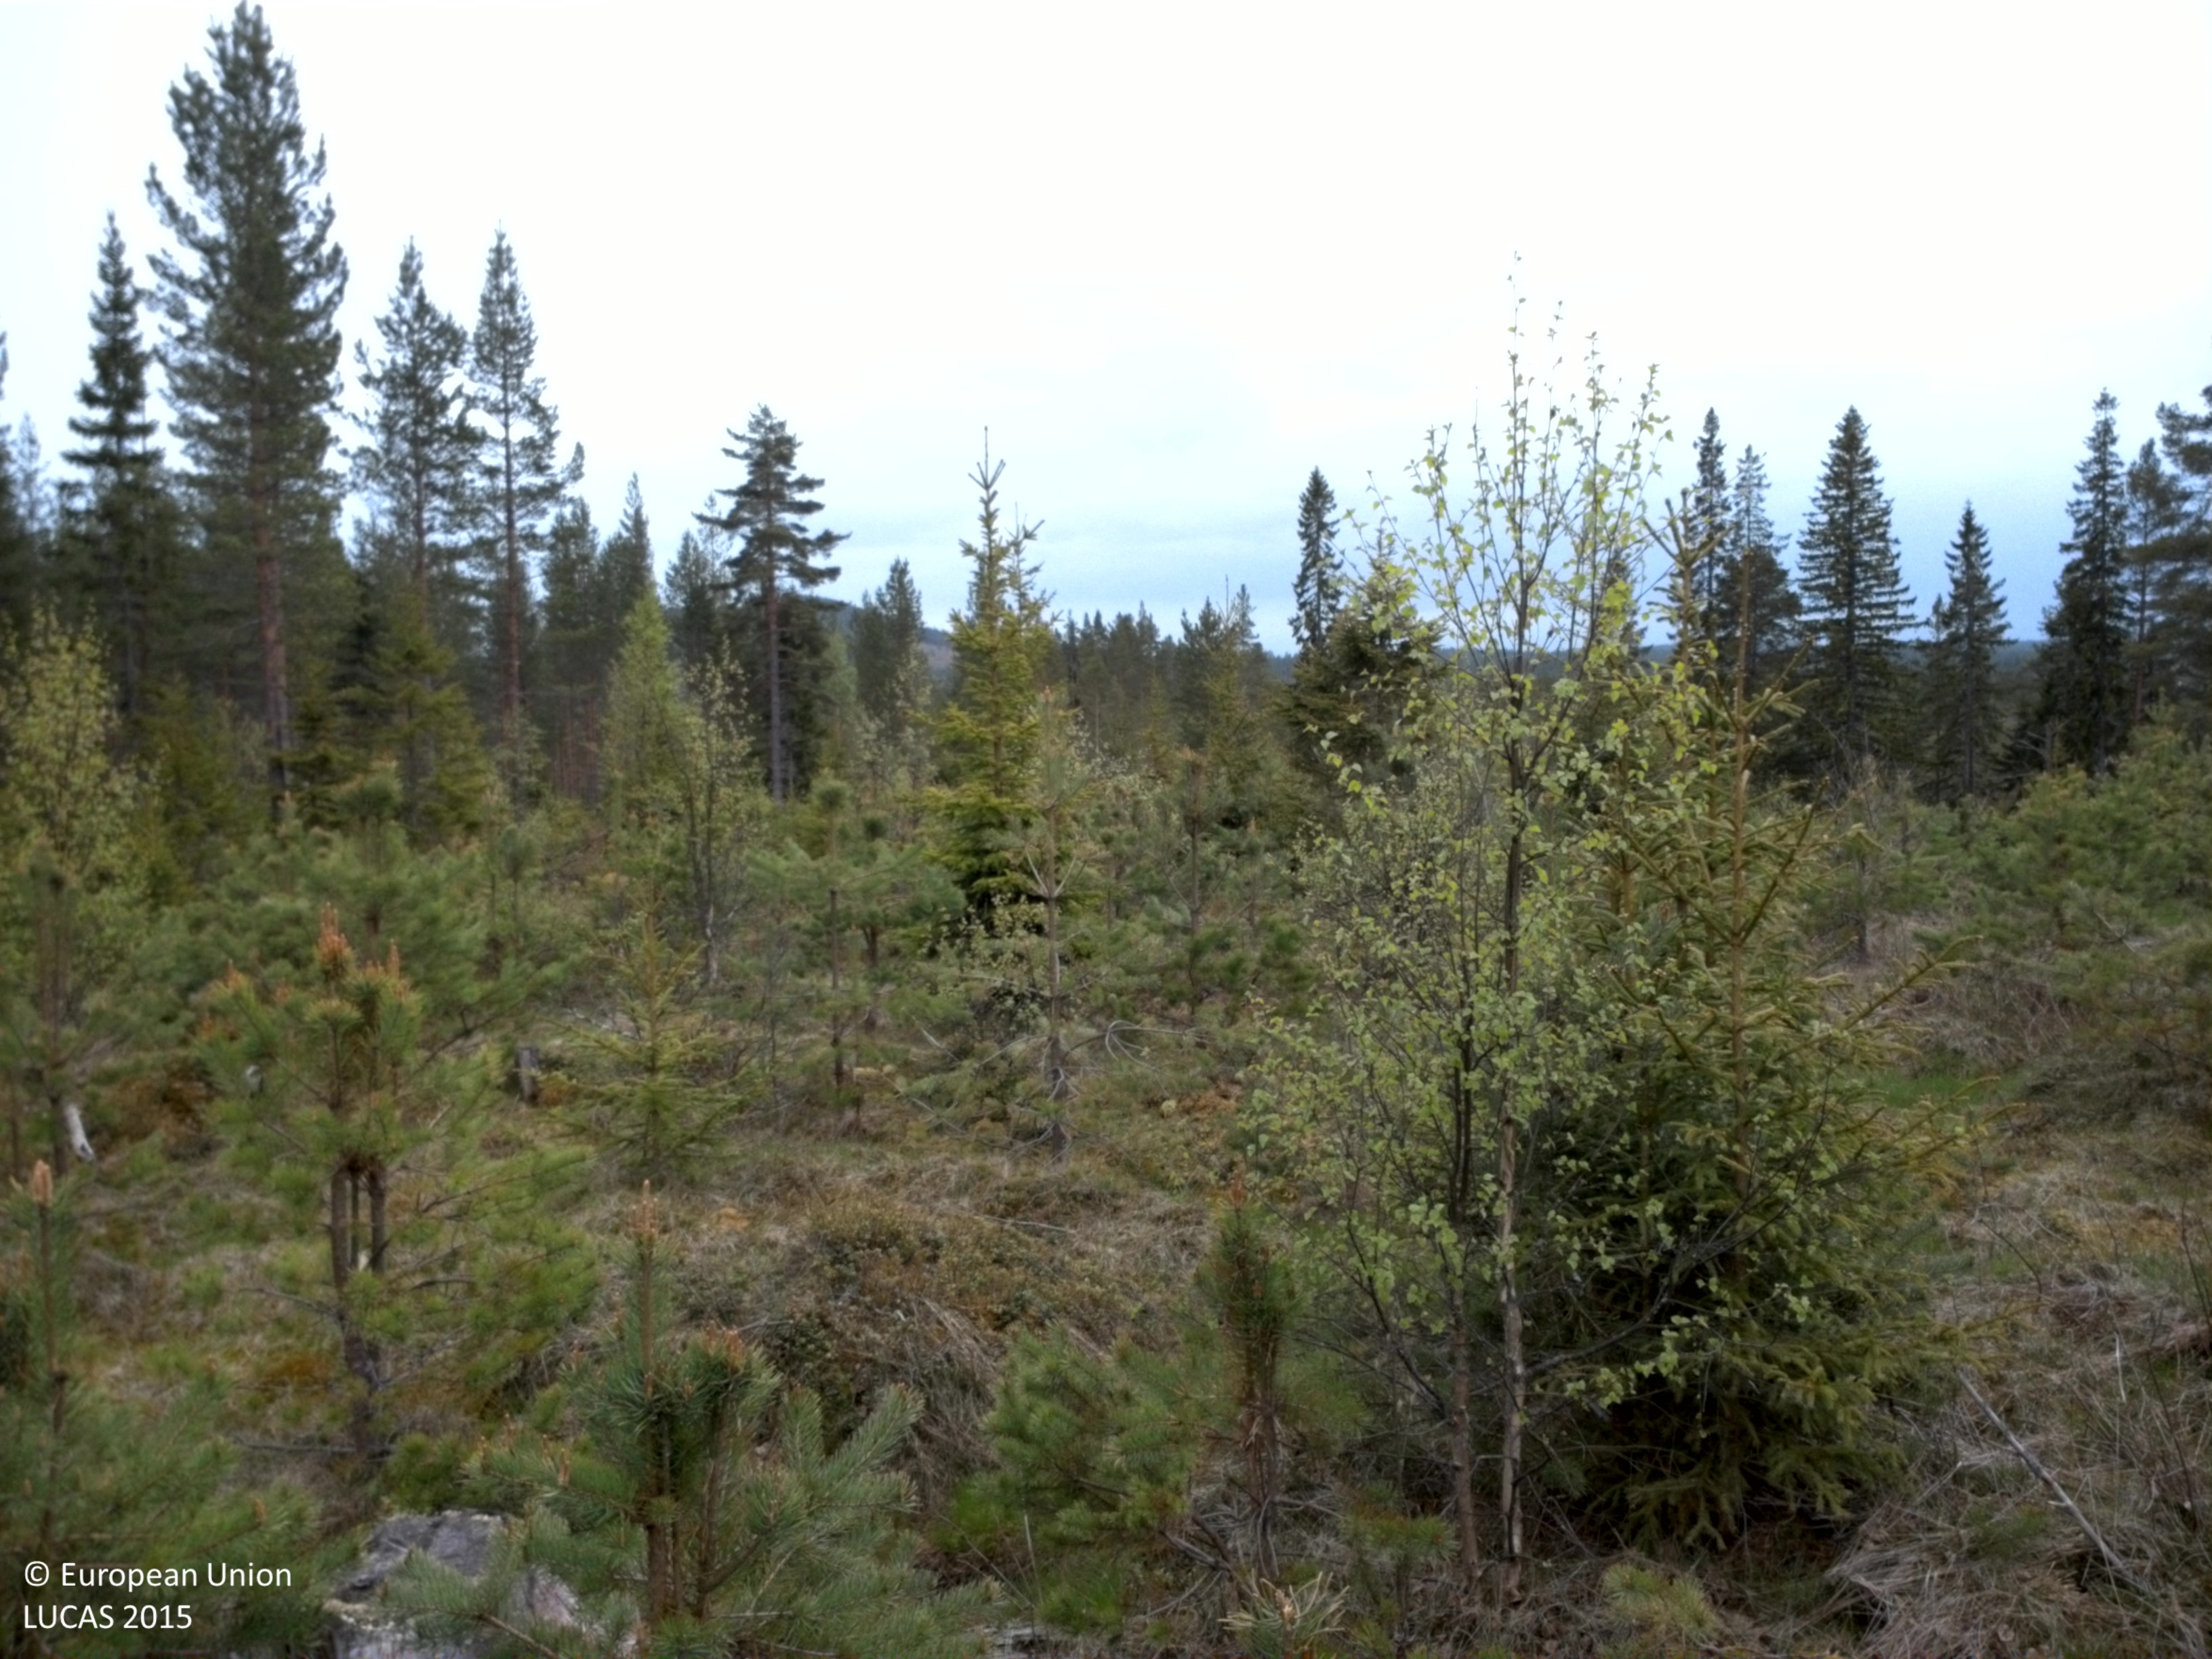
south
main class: Woodland
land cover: Pine dominated mixed woodland
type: boreal forest
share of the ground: 50 - 75 %
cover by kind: coniferous forest trees 50 %, broadleaved forest trees 25 %, herbaceous plants 25 %
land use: Forestry
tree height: < 5 m
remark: Clear cut
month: May
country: SE
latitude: 61.1608
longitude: 15.3935
